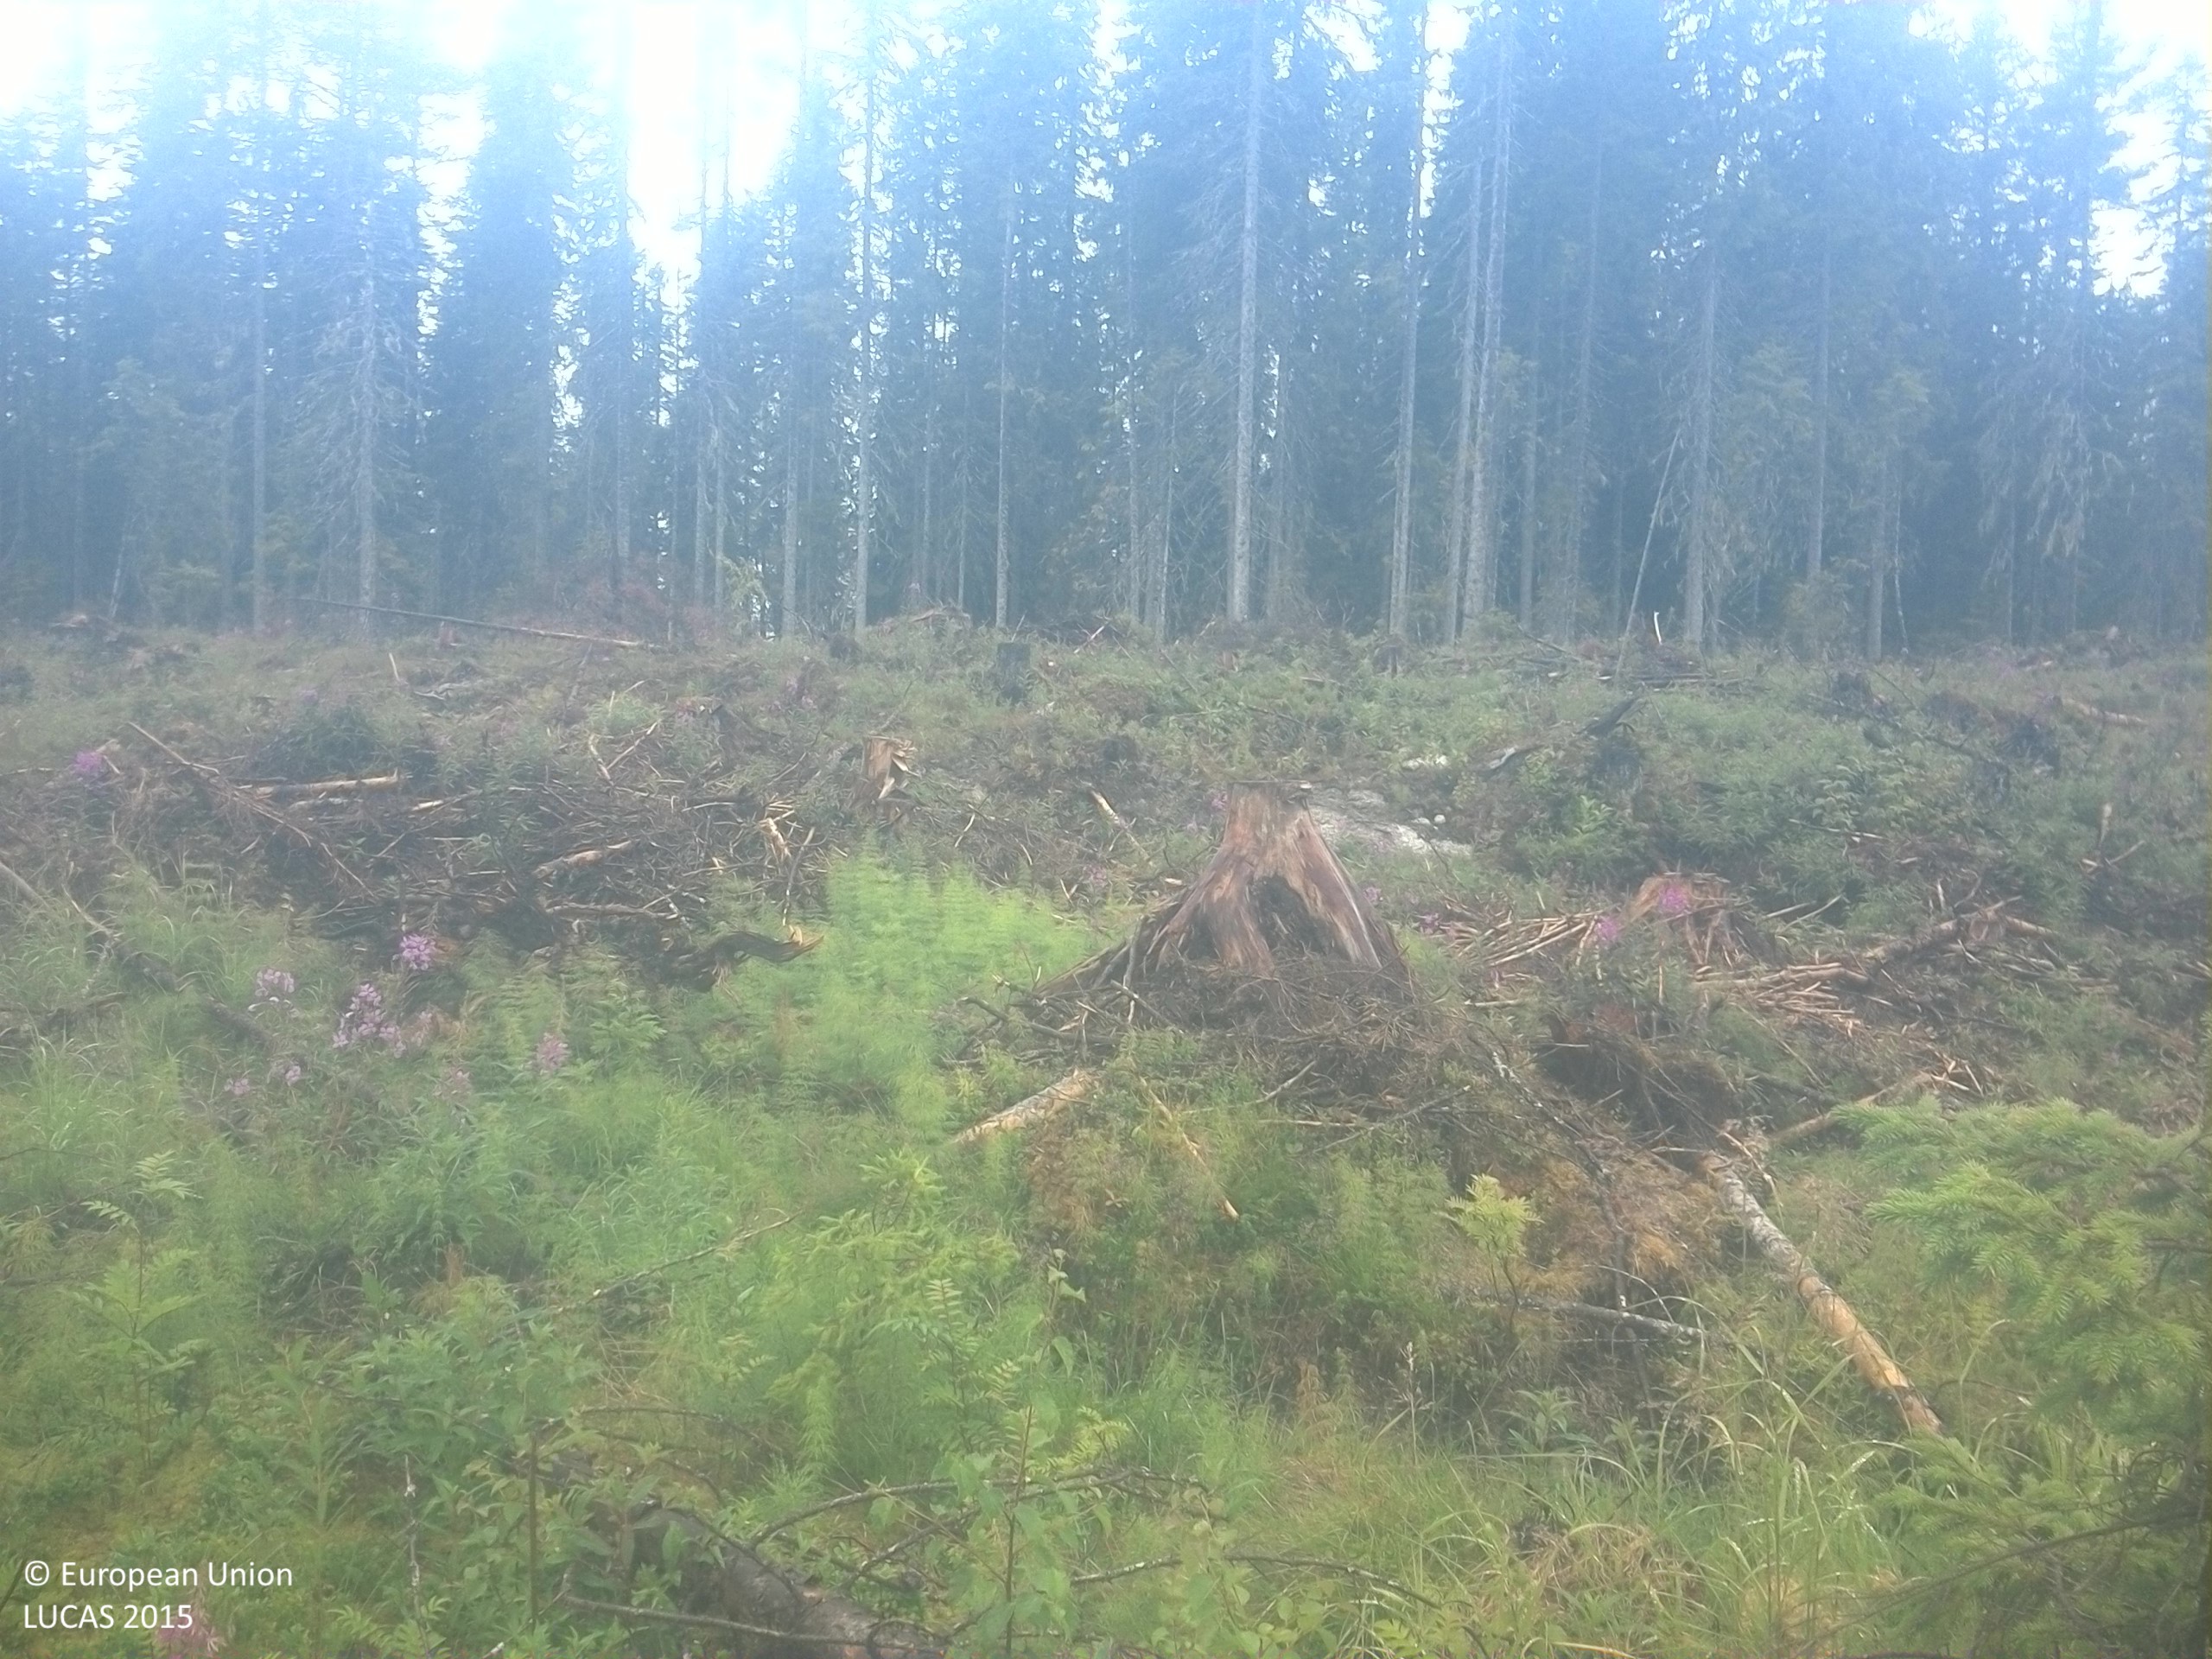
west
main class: Shrubland
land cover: Shrubland with sparse tree cover
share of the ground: 10 - 25 %
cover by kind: herbaceous plants 35 %, shrubs 20 %, lichens and mosses 15 %, unconsolidated bare surface 15 %, consolidated bare surface 10 %, coniferous forest trees 5 %
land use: Forestry
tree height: < 5 m
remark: Clear cut
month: August
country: SE
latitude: 63.5560
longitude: 16.5550
